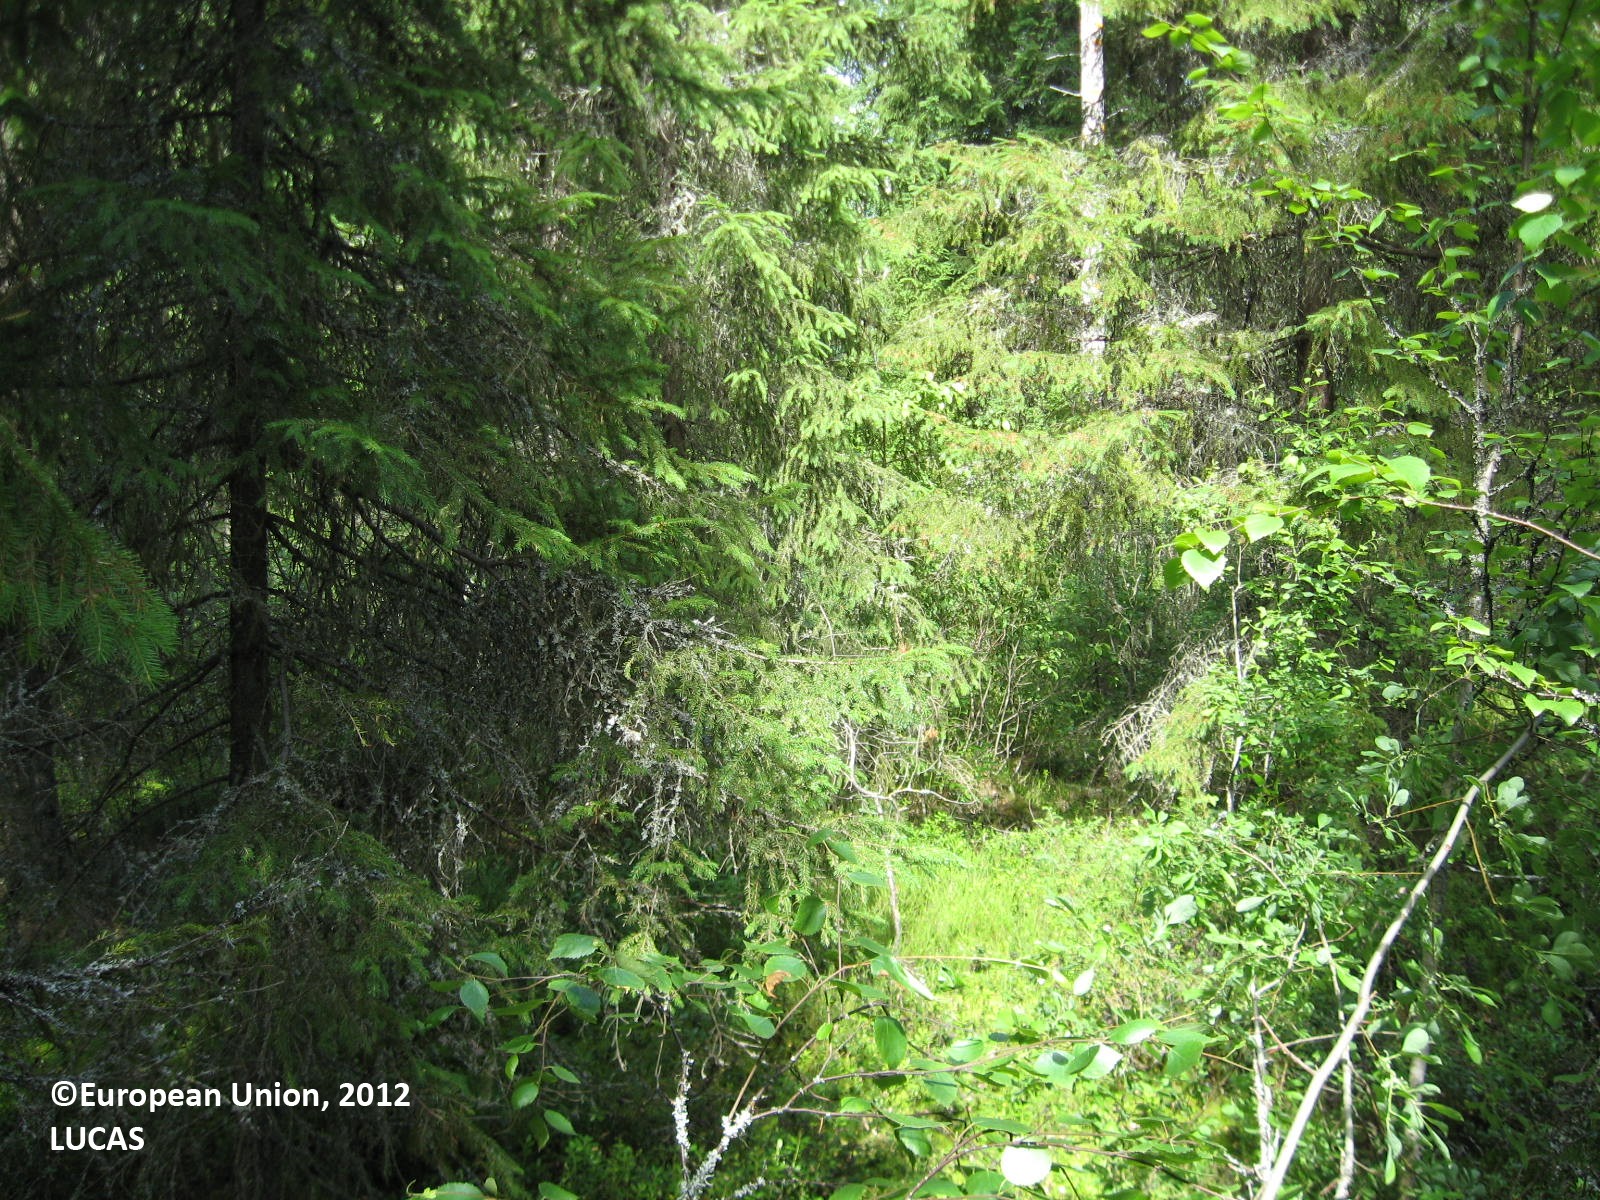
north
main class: Woodland
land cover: Spruce dominated mixed woodland
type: boreal forest
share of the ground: > 75 %
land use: Forestry
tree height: > 5 m
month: July
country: FI
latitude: 62.4593
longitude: 21.5401
